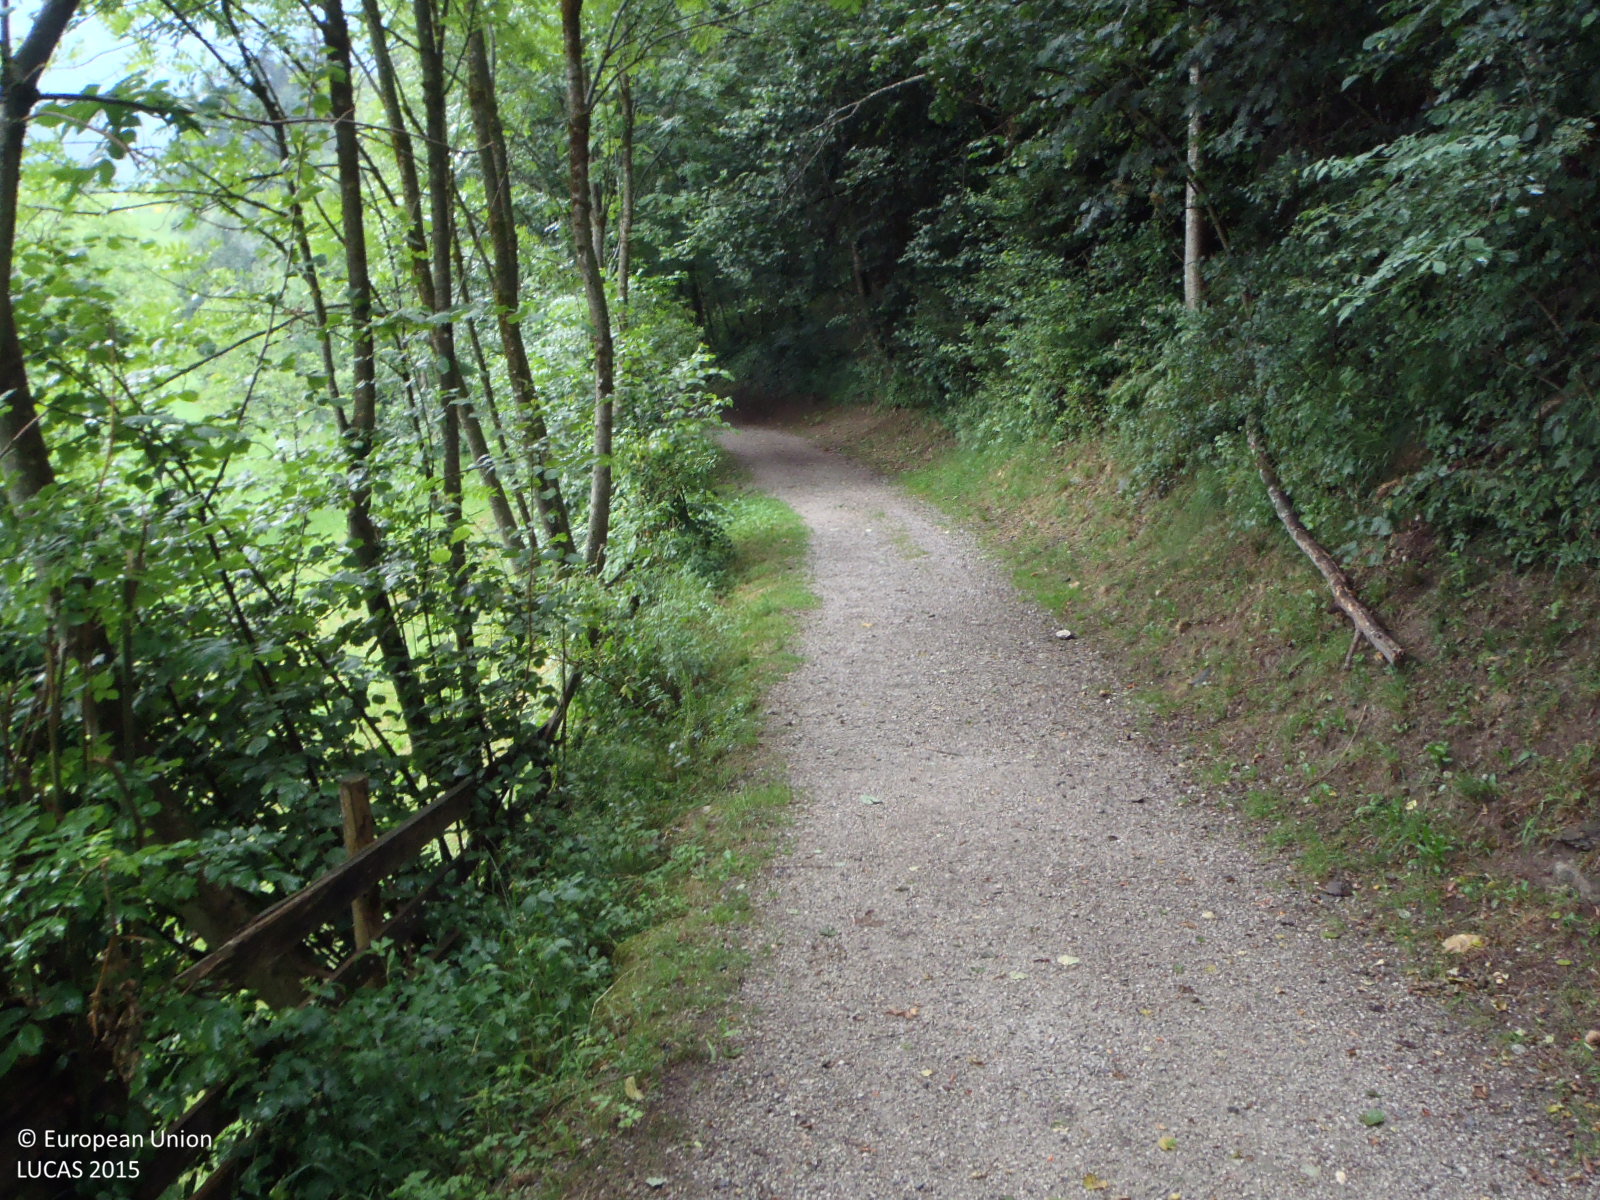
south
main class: Woodland
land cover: Spruce dominated mixed woodland
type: alpine coniferous forest
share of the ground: > 75 %
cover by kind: broadleaved forest trees 70 %, coniferous forest trees 30 %
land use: Forestry
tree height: > 5 m
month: July
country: AT
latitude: 47.1816
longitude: 11.8590
